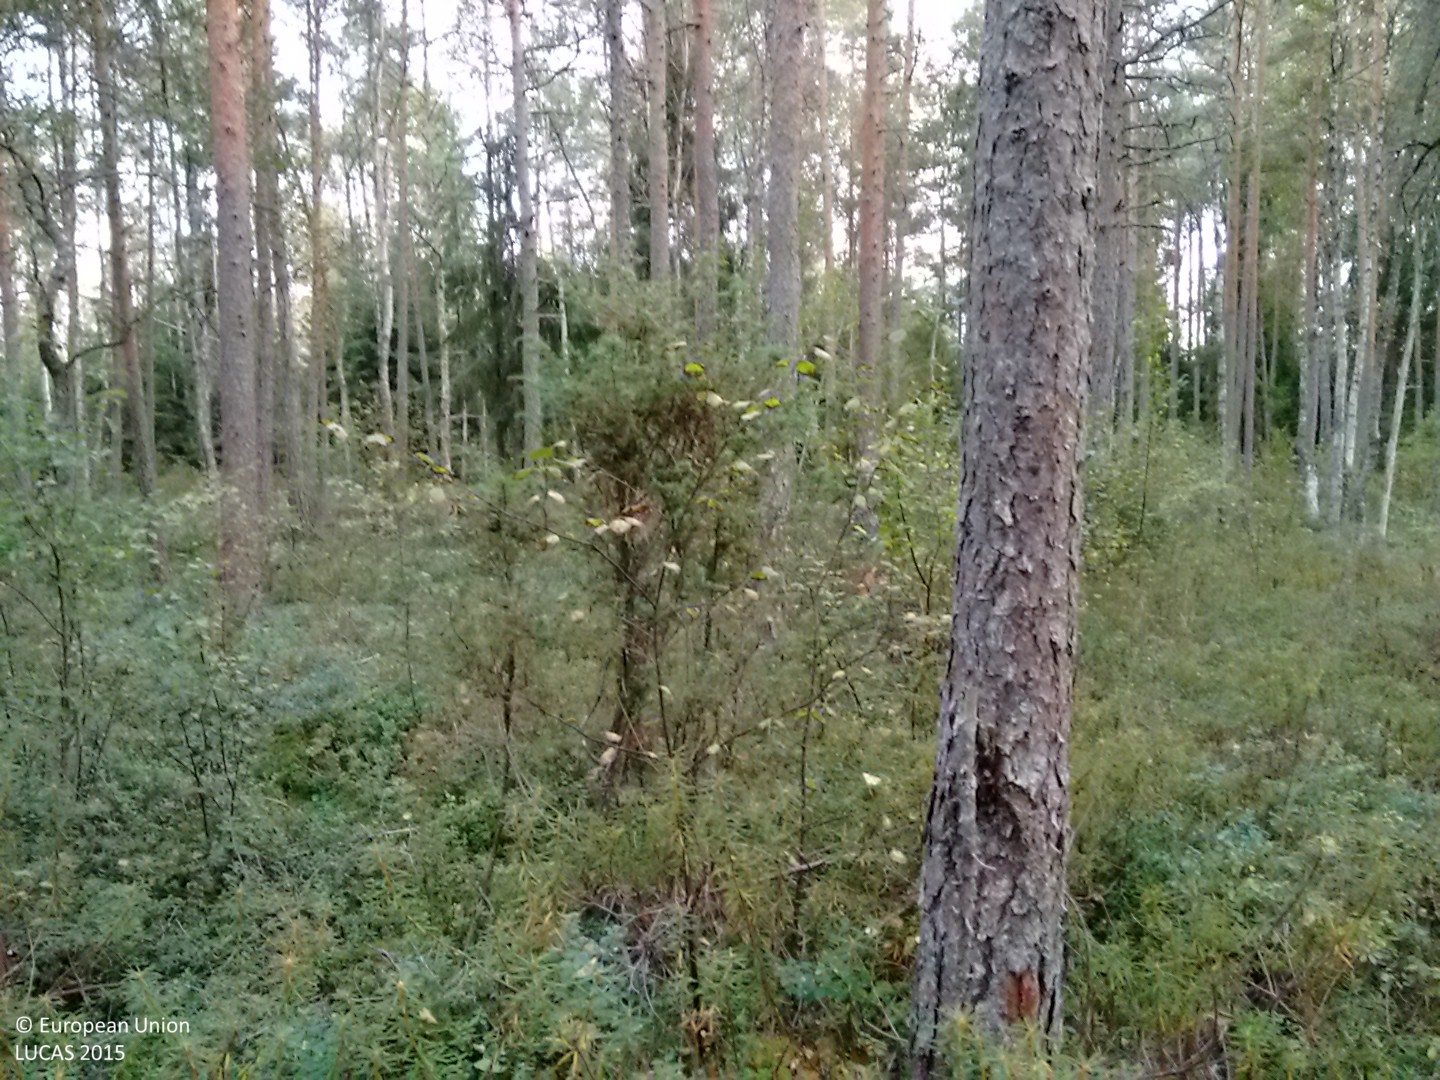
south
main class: Woodland
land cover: Pine dominated mixed woodland
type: hemiboreal forest and nemoral coniferous forest and mixed broadleaved-coniferous forest
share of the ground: > 75 %
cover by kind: coniferous forest trees 60 %, broadleaved forest trees 20 %, shrubs 20 %
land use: Forestry
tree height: > 5 m
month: September
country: FI
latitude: 60.9407
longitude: 21.5904
